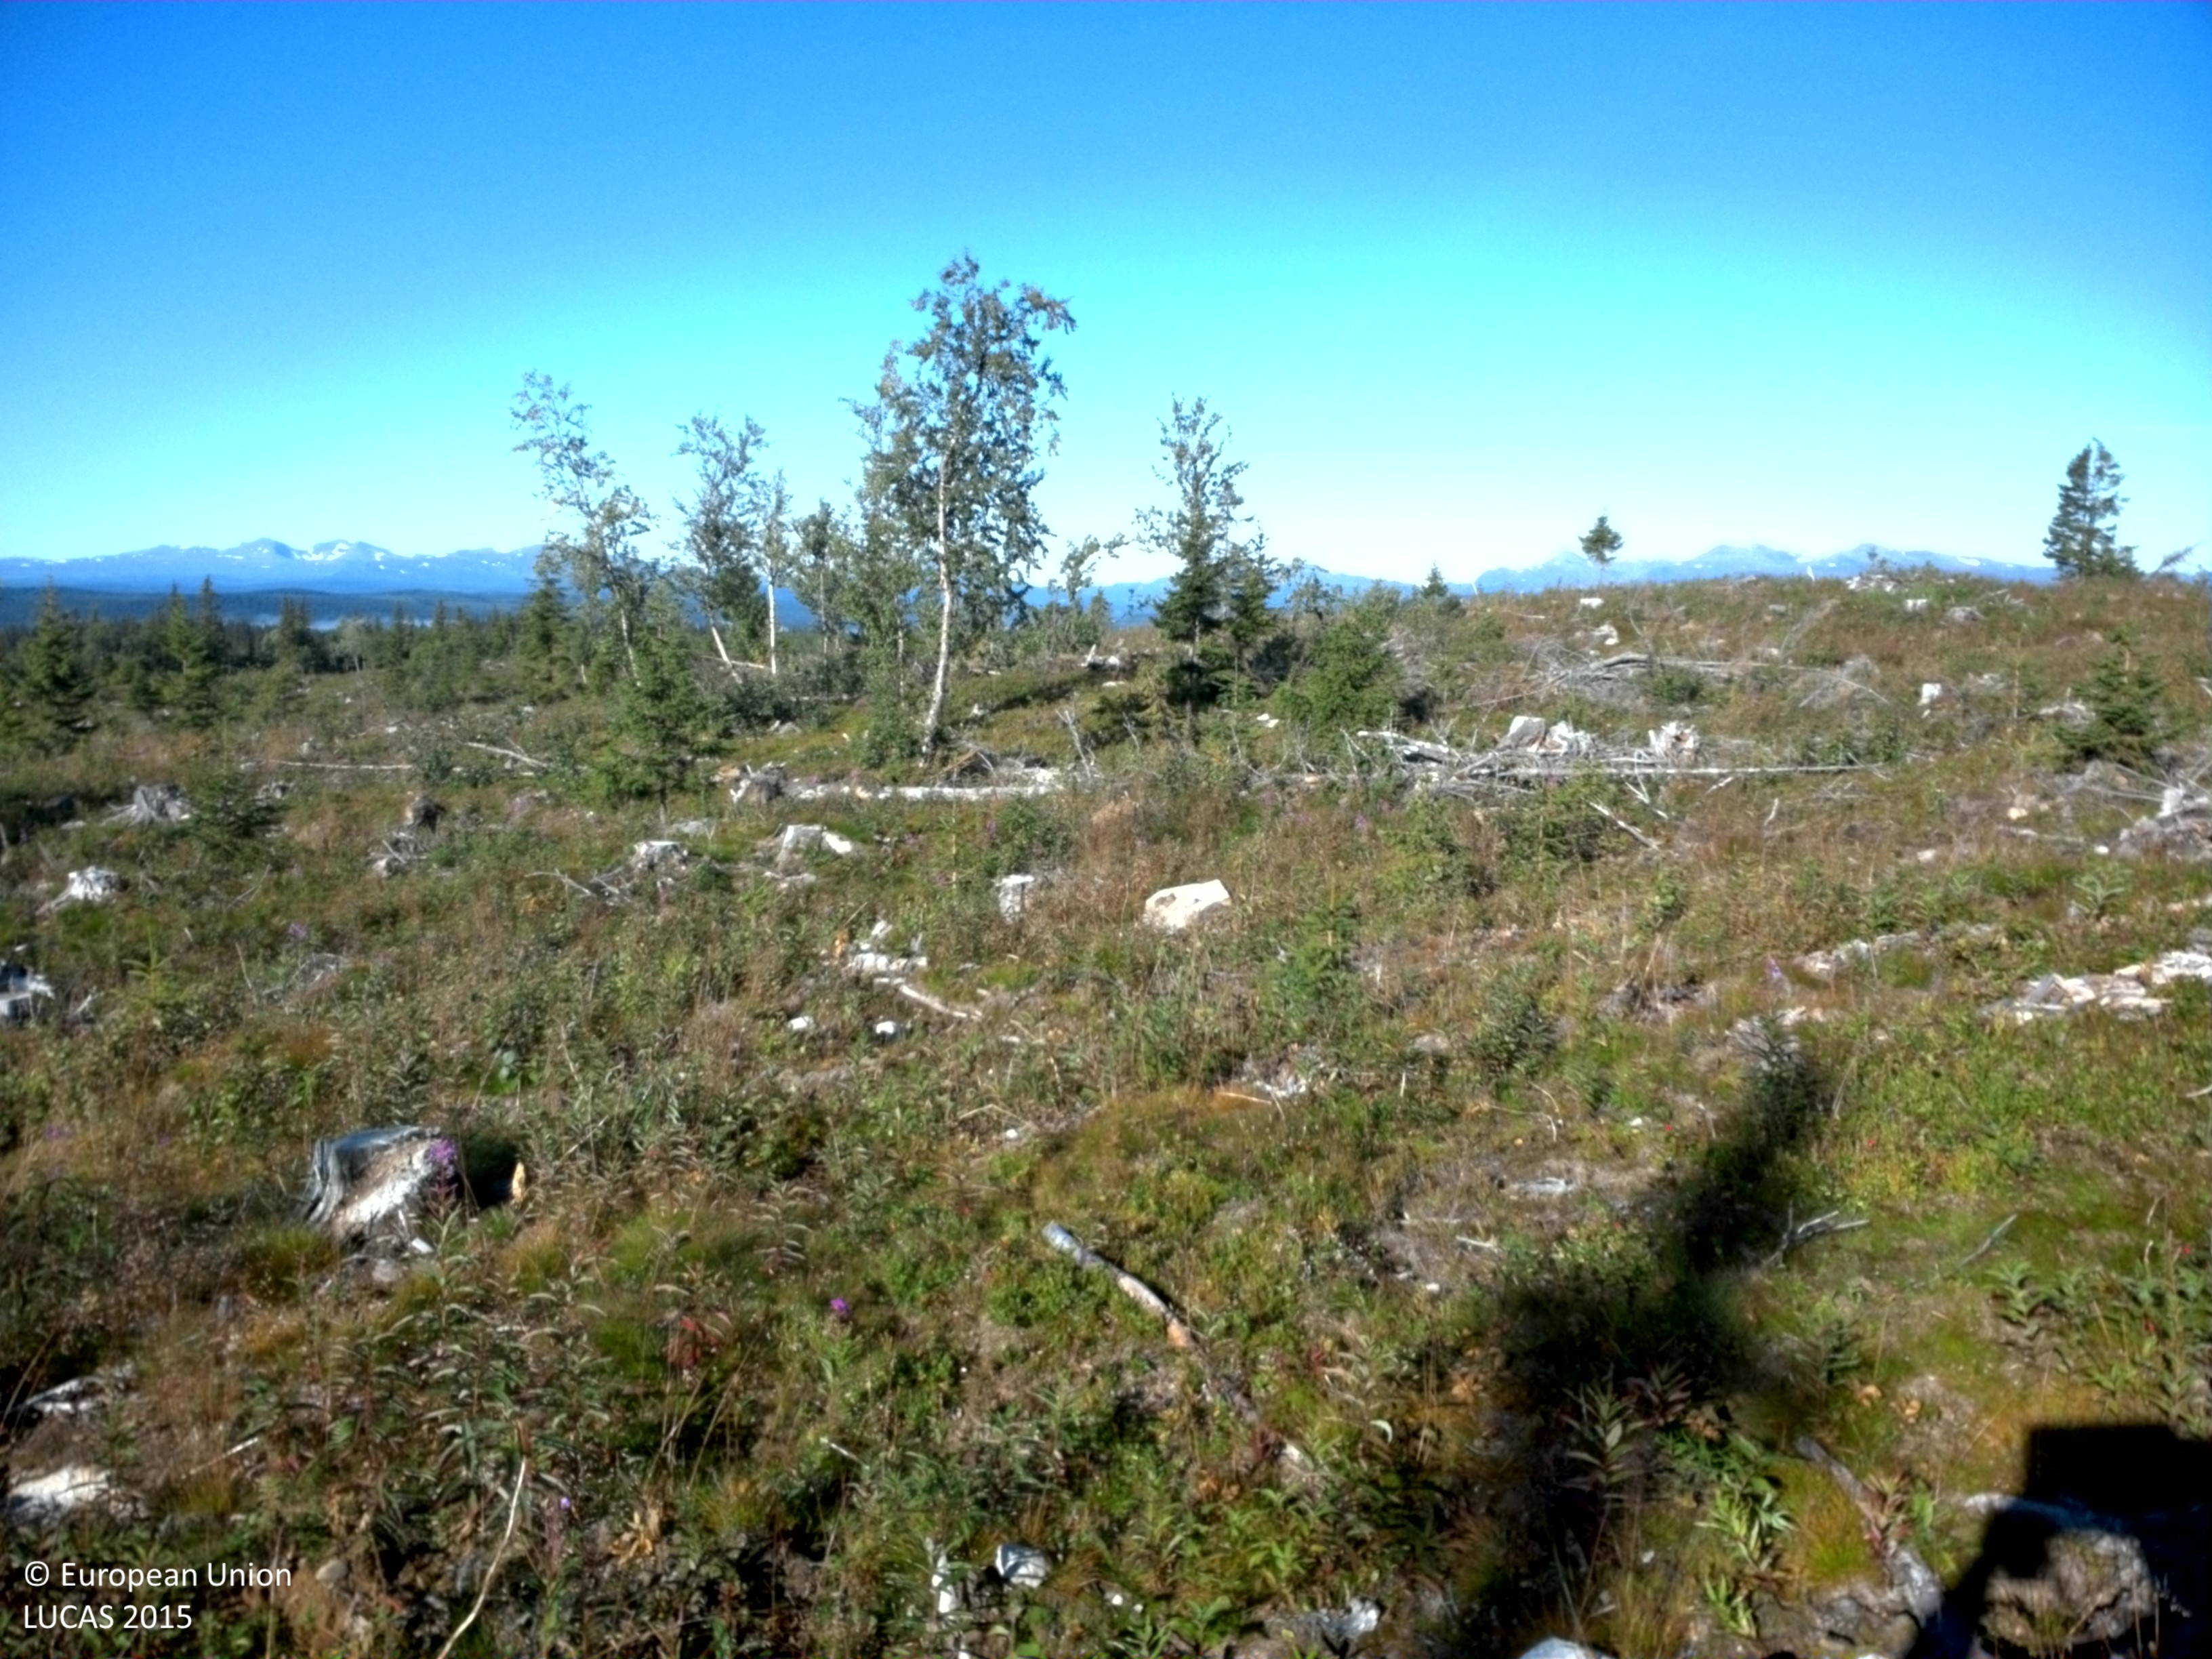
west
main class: Shrubland
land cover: Shrubland with sparse tree cover
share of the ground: 10 - 25 %
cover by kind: herbaceous plants 65 %, shrubs 20 %, broadleaved forest trees 5 %, lichens and mosses 5 %, unconsolidated bare surface 5 %
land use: Forestry
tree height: < 5 m
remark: Clear cut
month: September
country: SE
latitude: 65.2216
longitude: 16.1441
